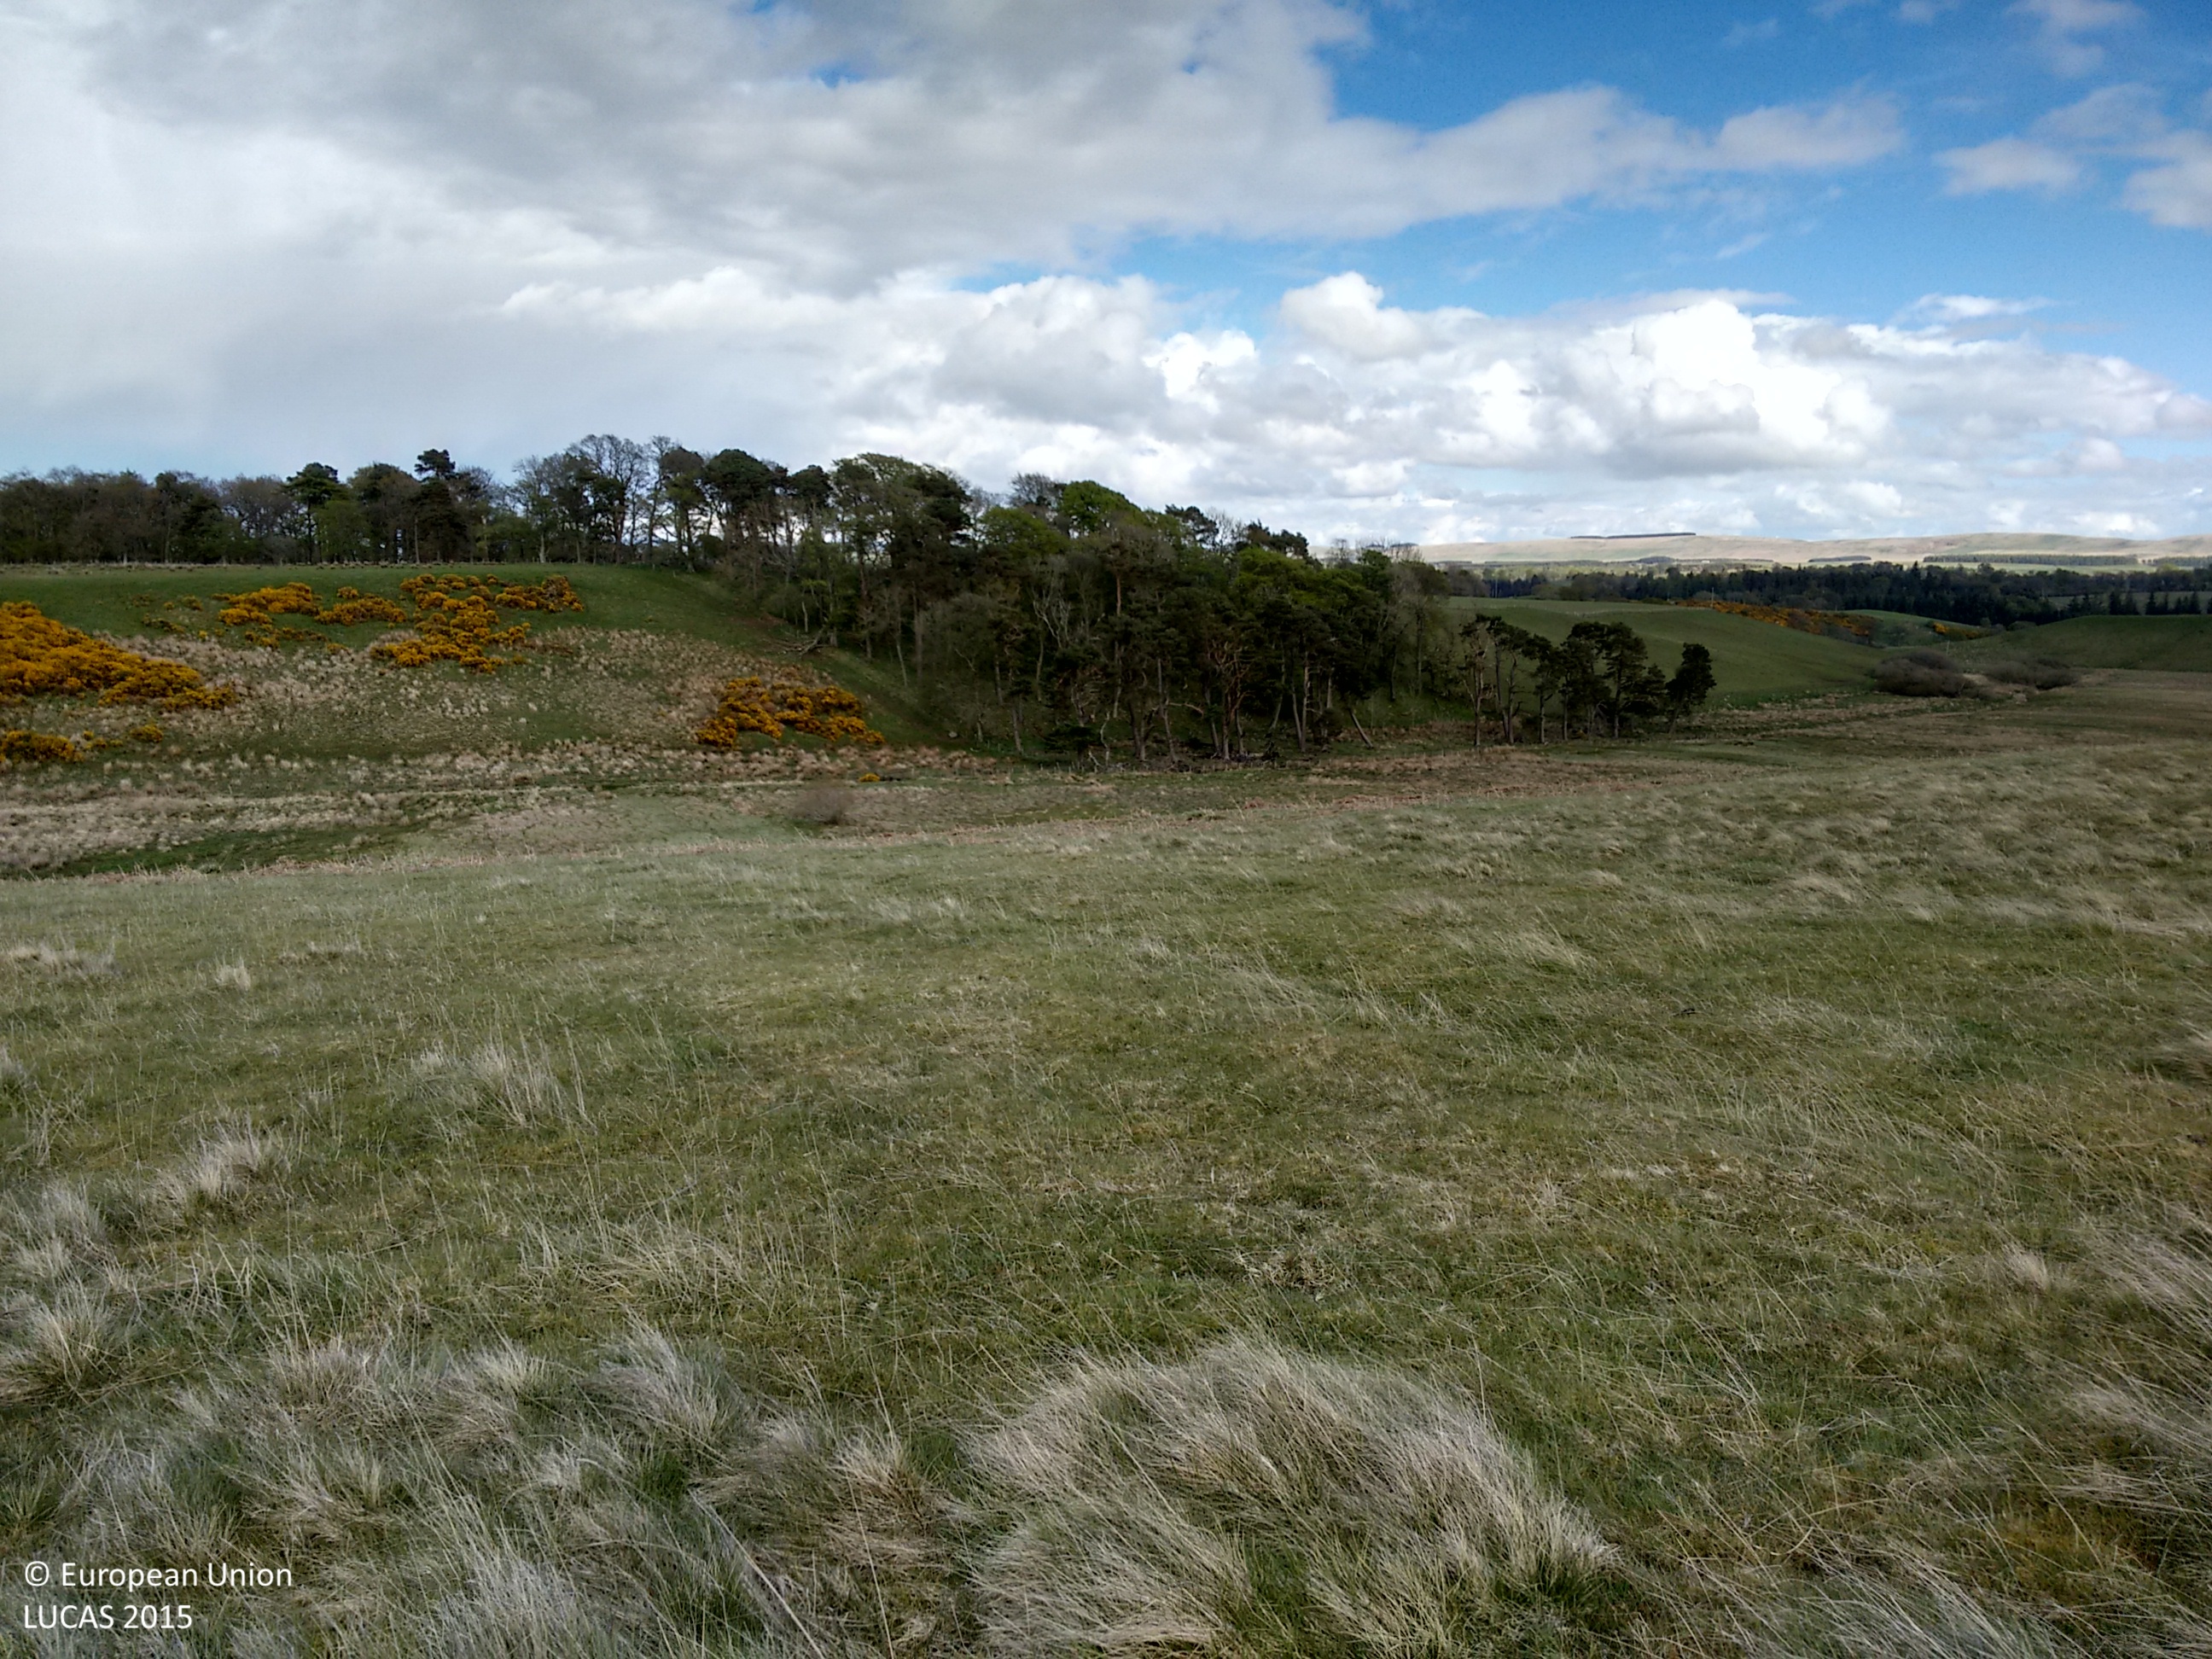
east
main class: Grassland
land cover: Grassland without tree/shrub cover
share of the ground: > 75 %
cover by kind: herbaceous plants 100 %
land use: Agriculture (excluding fallow land and kitchen gardens)
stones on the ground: < 10 %
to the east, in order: Grassland without tree/shrub cover; Rivers and streams; Grass margins; Fences; Grassland without tree/shrub cover; Fences; Pine dominated coniferous woodland
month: May
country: GB
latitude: 55.8181
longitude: -3.1422
